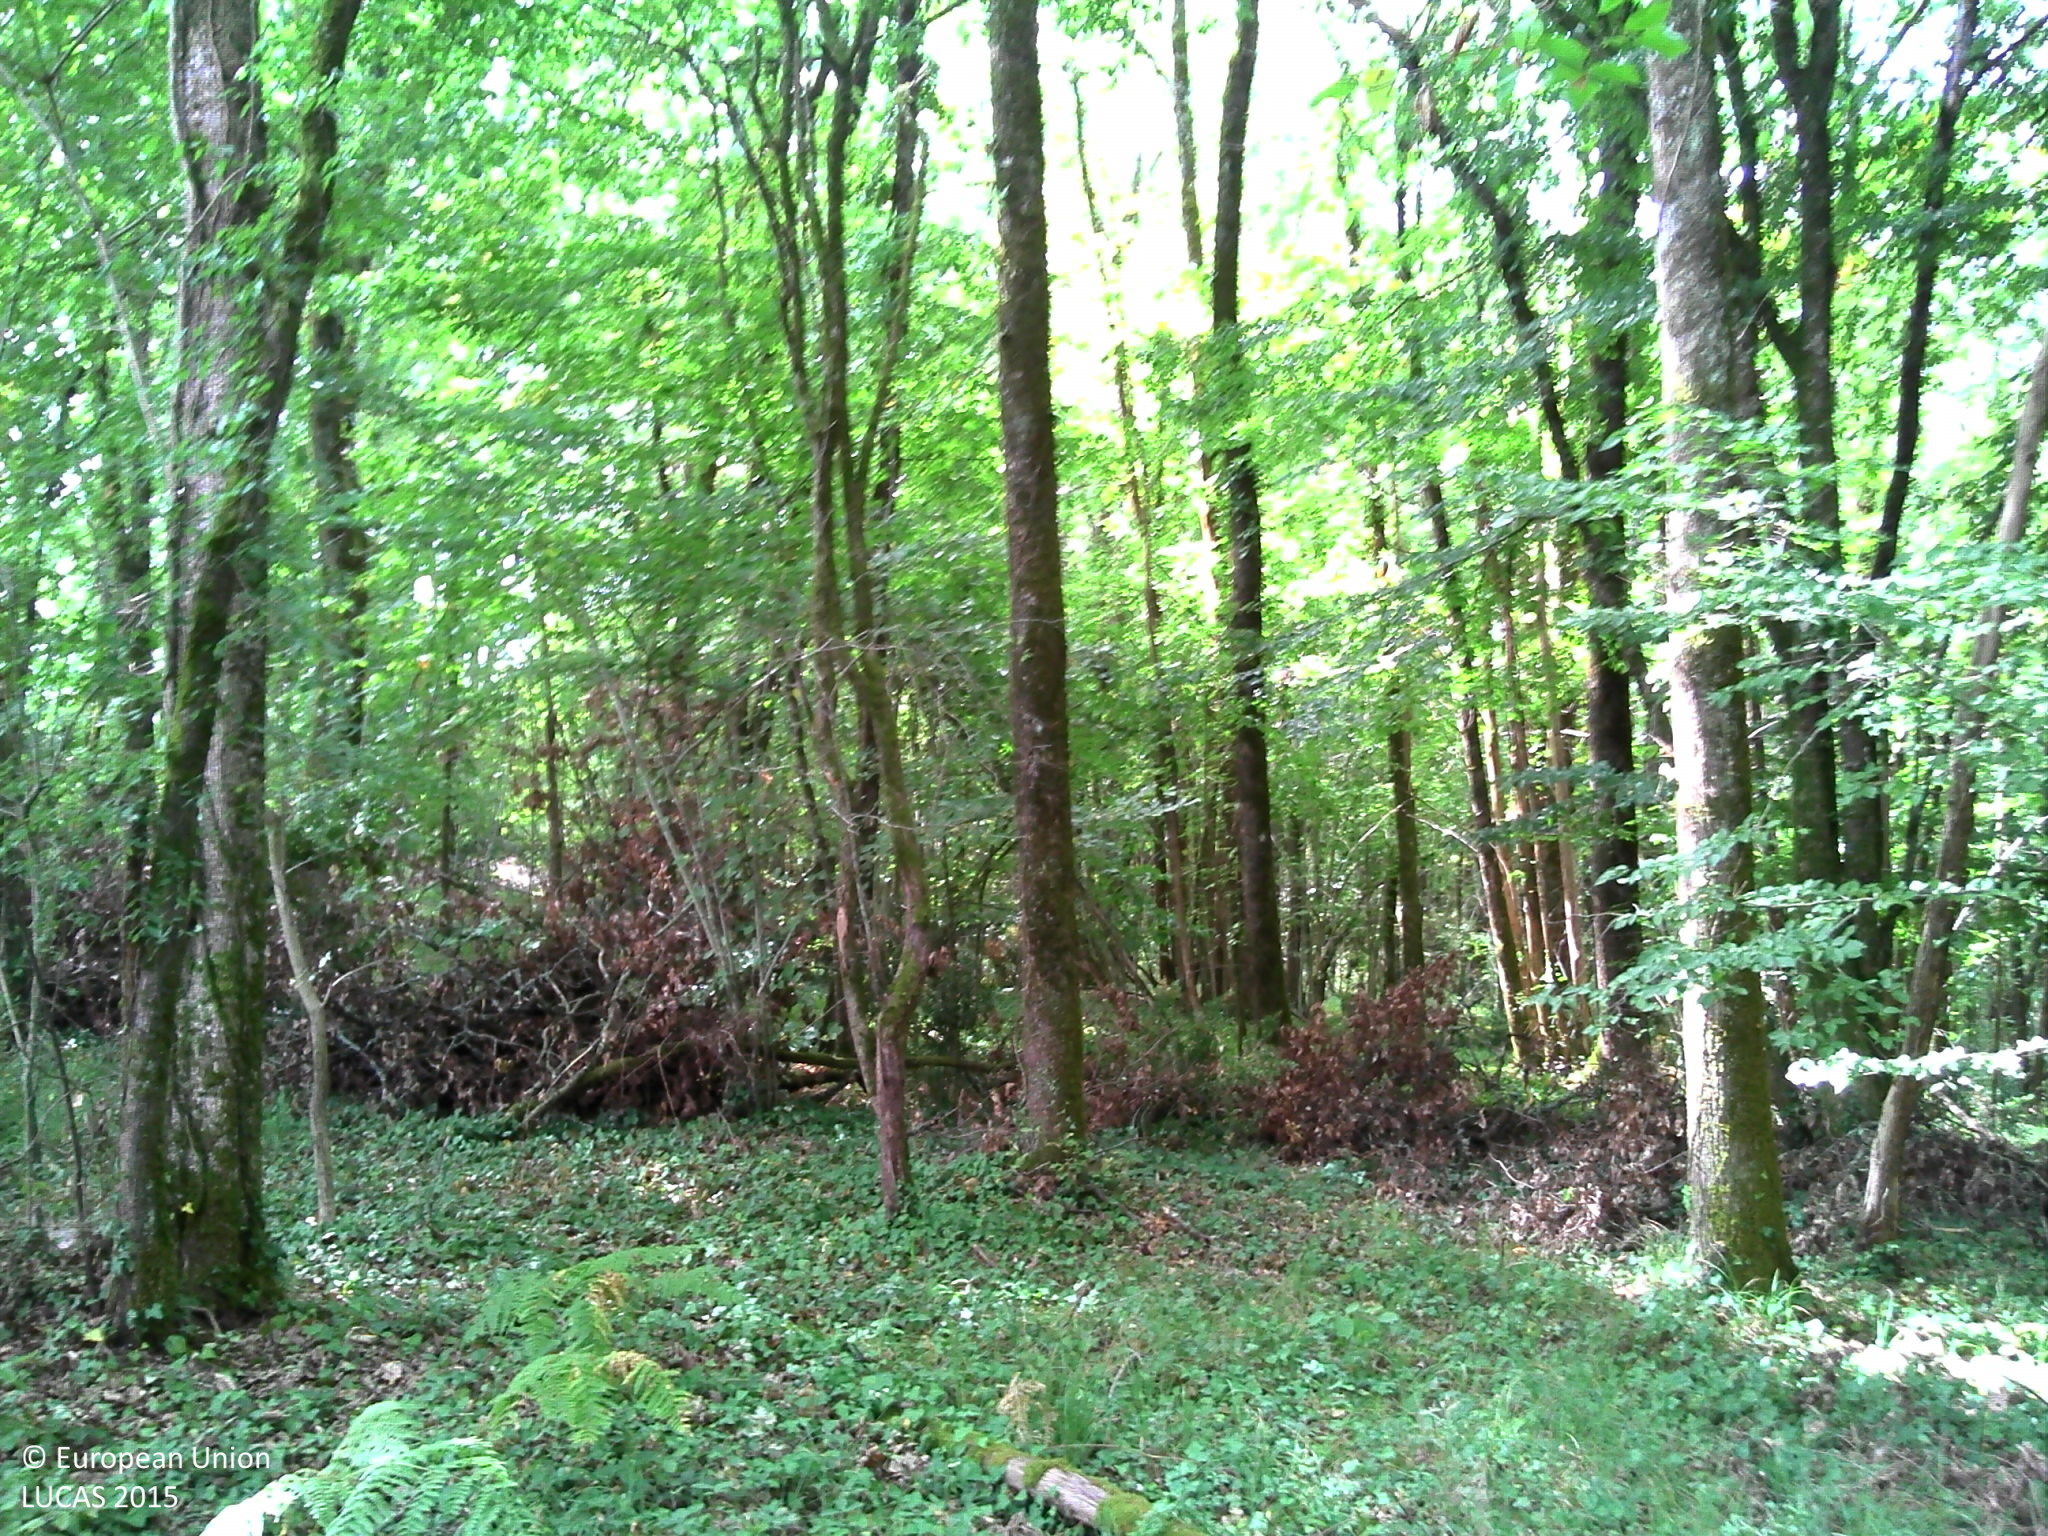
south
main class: Woodland
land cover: Broadleaved woodland
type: thermophilous deciduous forest
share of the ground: > 75 %
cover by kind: broadleaved forest trees 80 %, herbaceous plants 10 %, shrubs 5 %, lichens and mosses 5 %
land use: Forestry
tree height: > 5 m
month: July
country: FR
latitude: 44.9056
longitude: 0.8355
